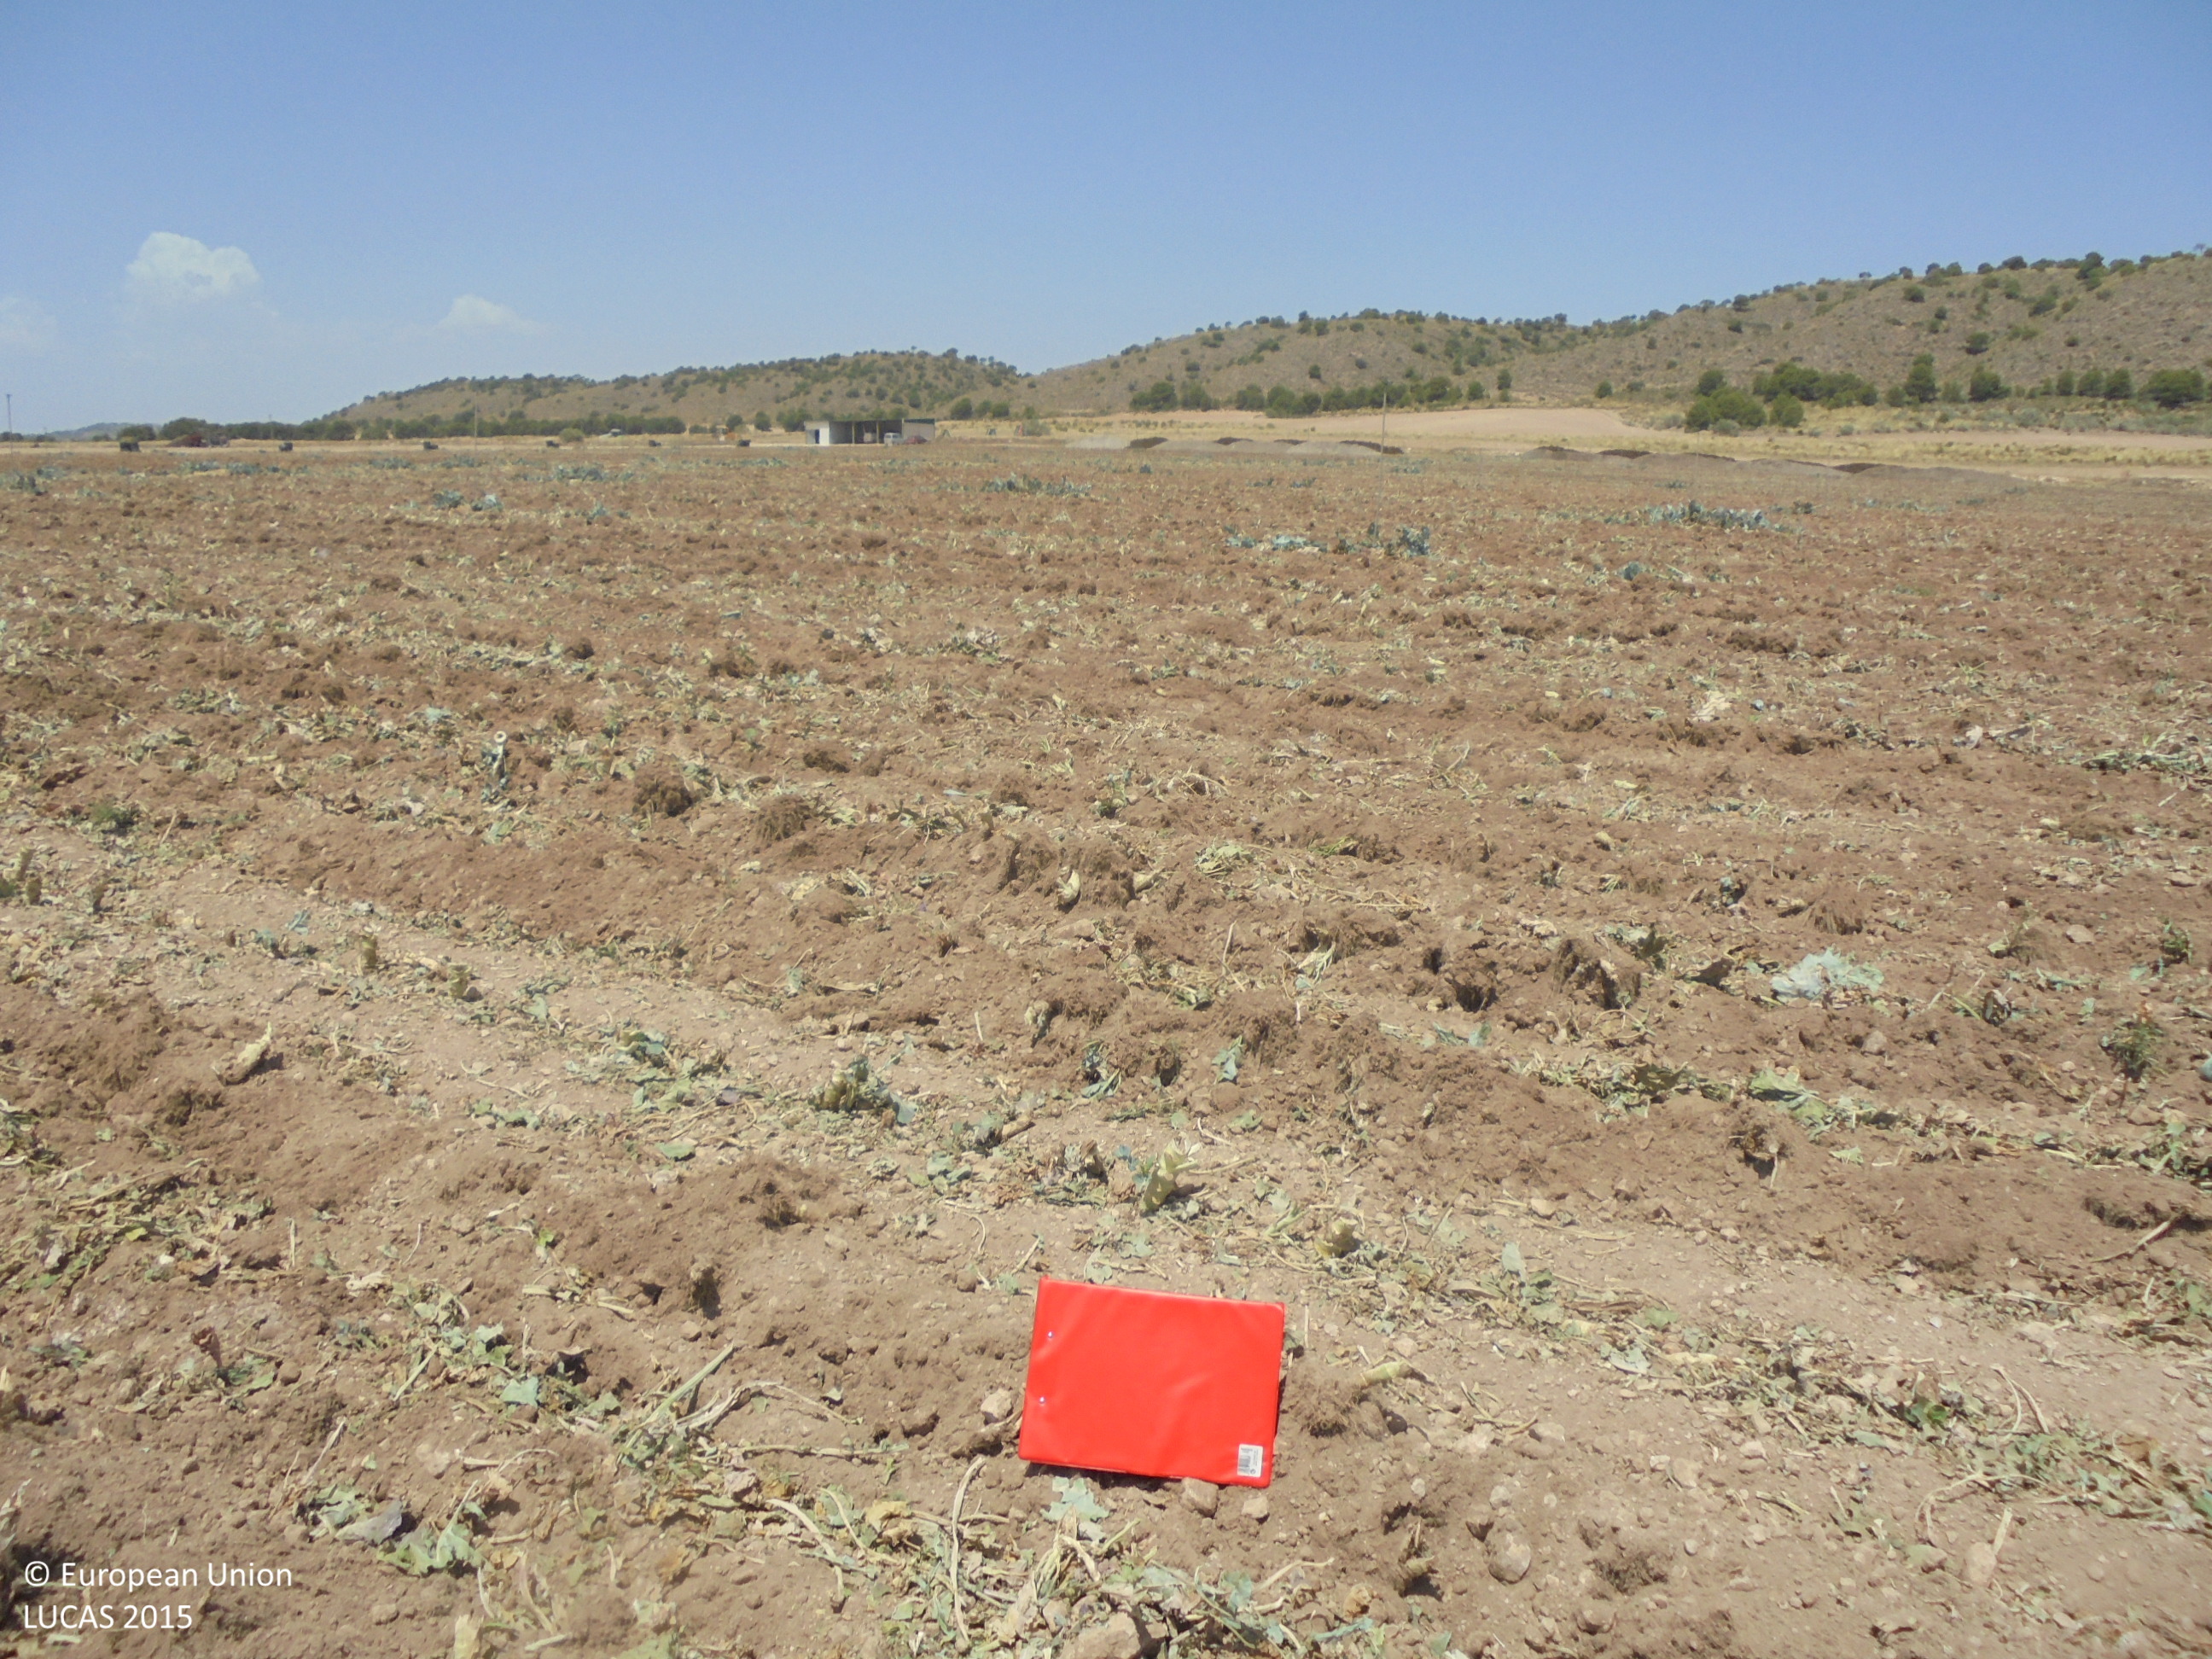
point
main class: Cropland
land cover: Other fresh vegetables
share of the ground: < 10 %
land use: Agriculture (excluding fallow land and kitchen gardens)
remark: Harvested field
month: July
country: ES
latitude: 38.6712
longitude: -1.6843
